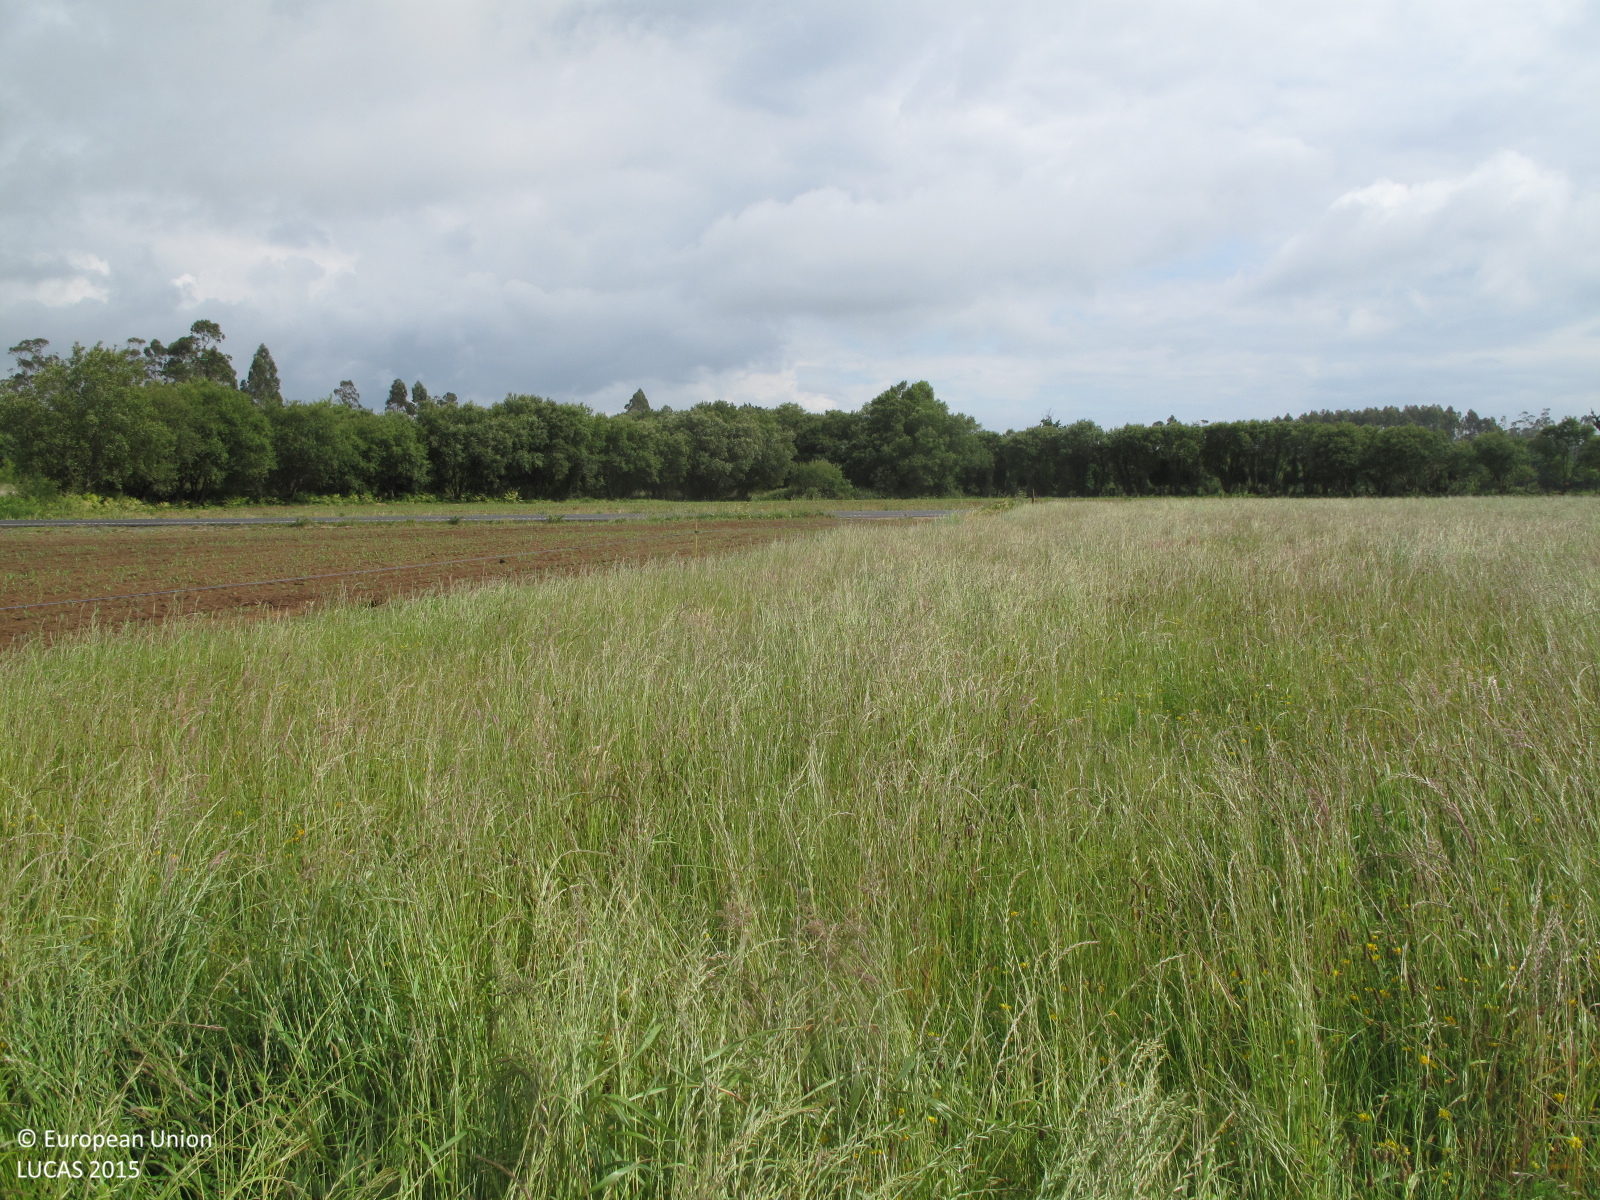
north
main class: Grassland
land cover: Grassland without tree/shrub cover
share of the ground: > 75 %
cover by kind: herbaceous plants 100 %
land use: Agriculture (excluding fallow land and kitchen gardens)
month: June
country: ES
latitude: 43.1289
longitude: -8.6104
